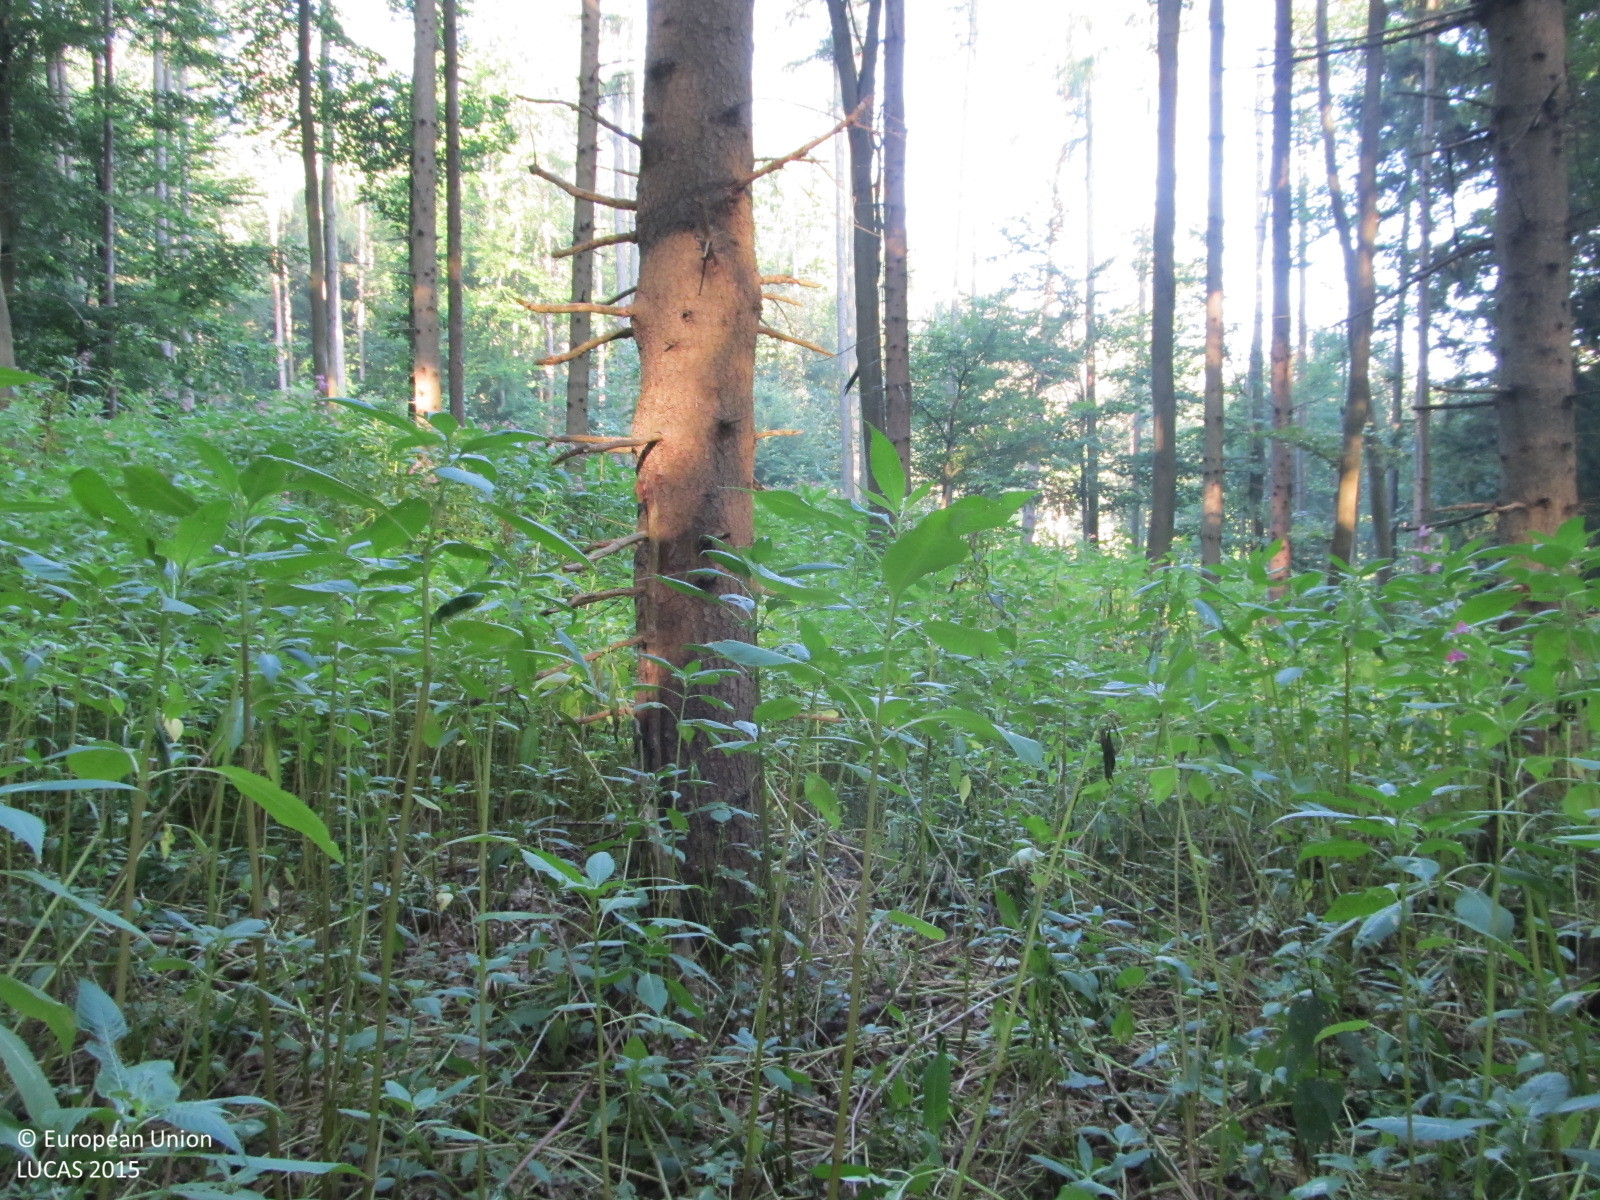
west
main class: Woodland
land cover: Spruce dominated mixed woodland
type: hemiboreal forest and nemoral coniferous forest and mixed broadleaved-coniferous forest
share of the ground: 50 - 75 %
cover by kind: coniferous forest trees 35 %, broadleaved forest trees 35 %, herbaceous plants 20 %, shrubs 10 %
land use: Forestry
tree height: > 5 m
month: August
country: AT
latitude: 48.2315
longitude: 15.8327
